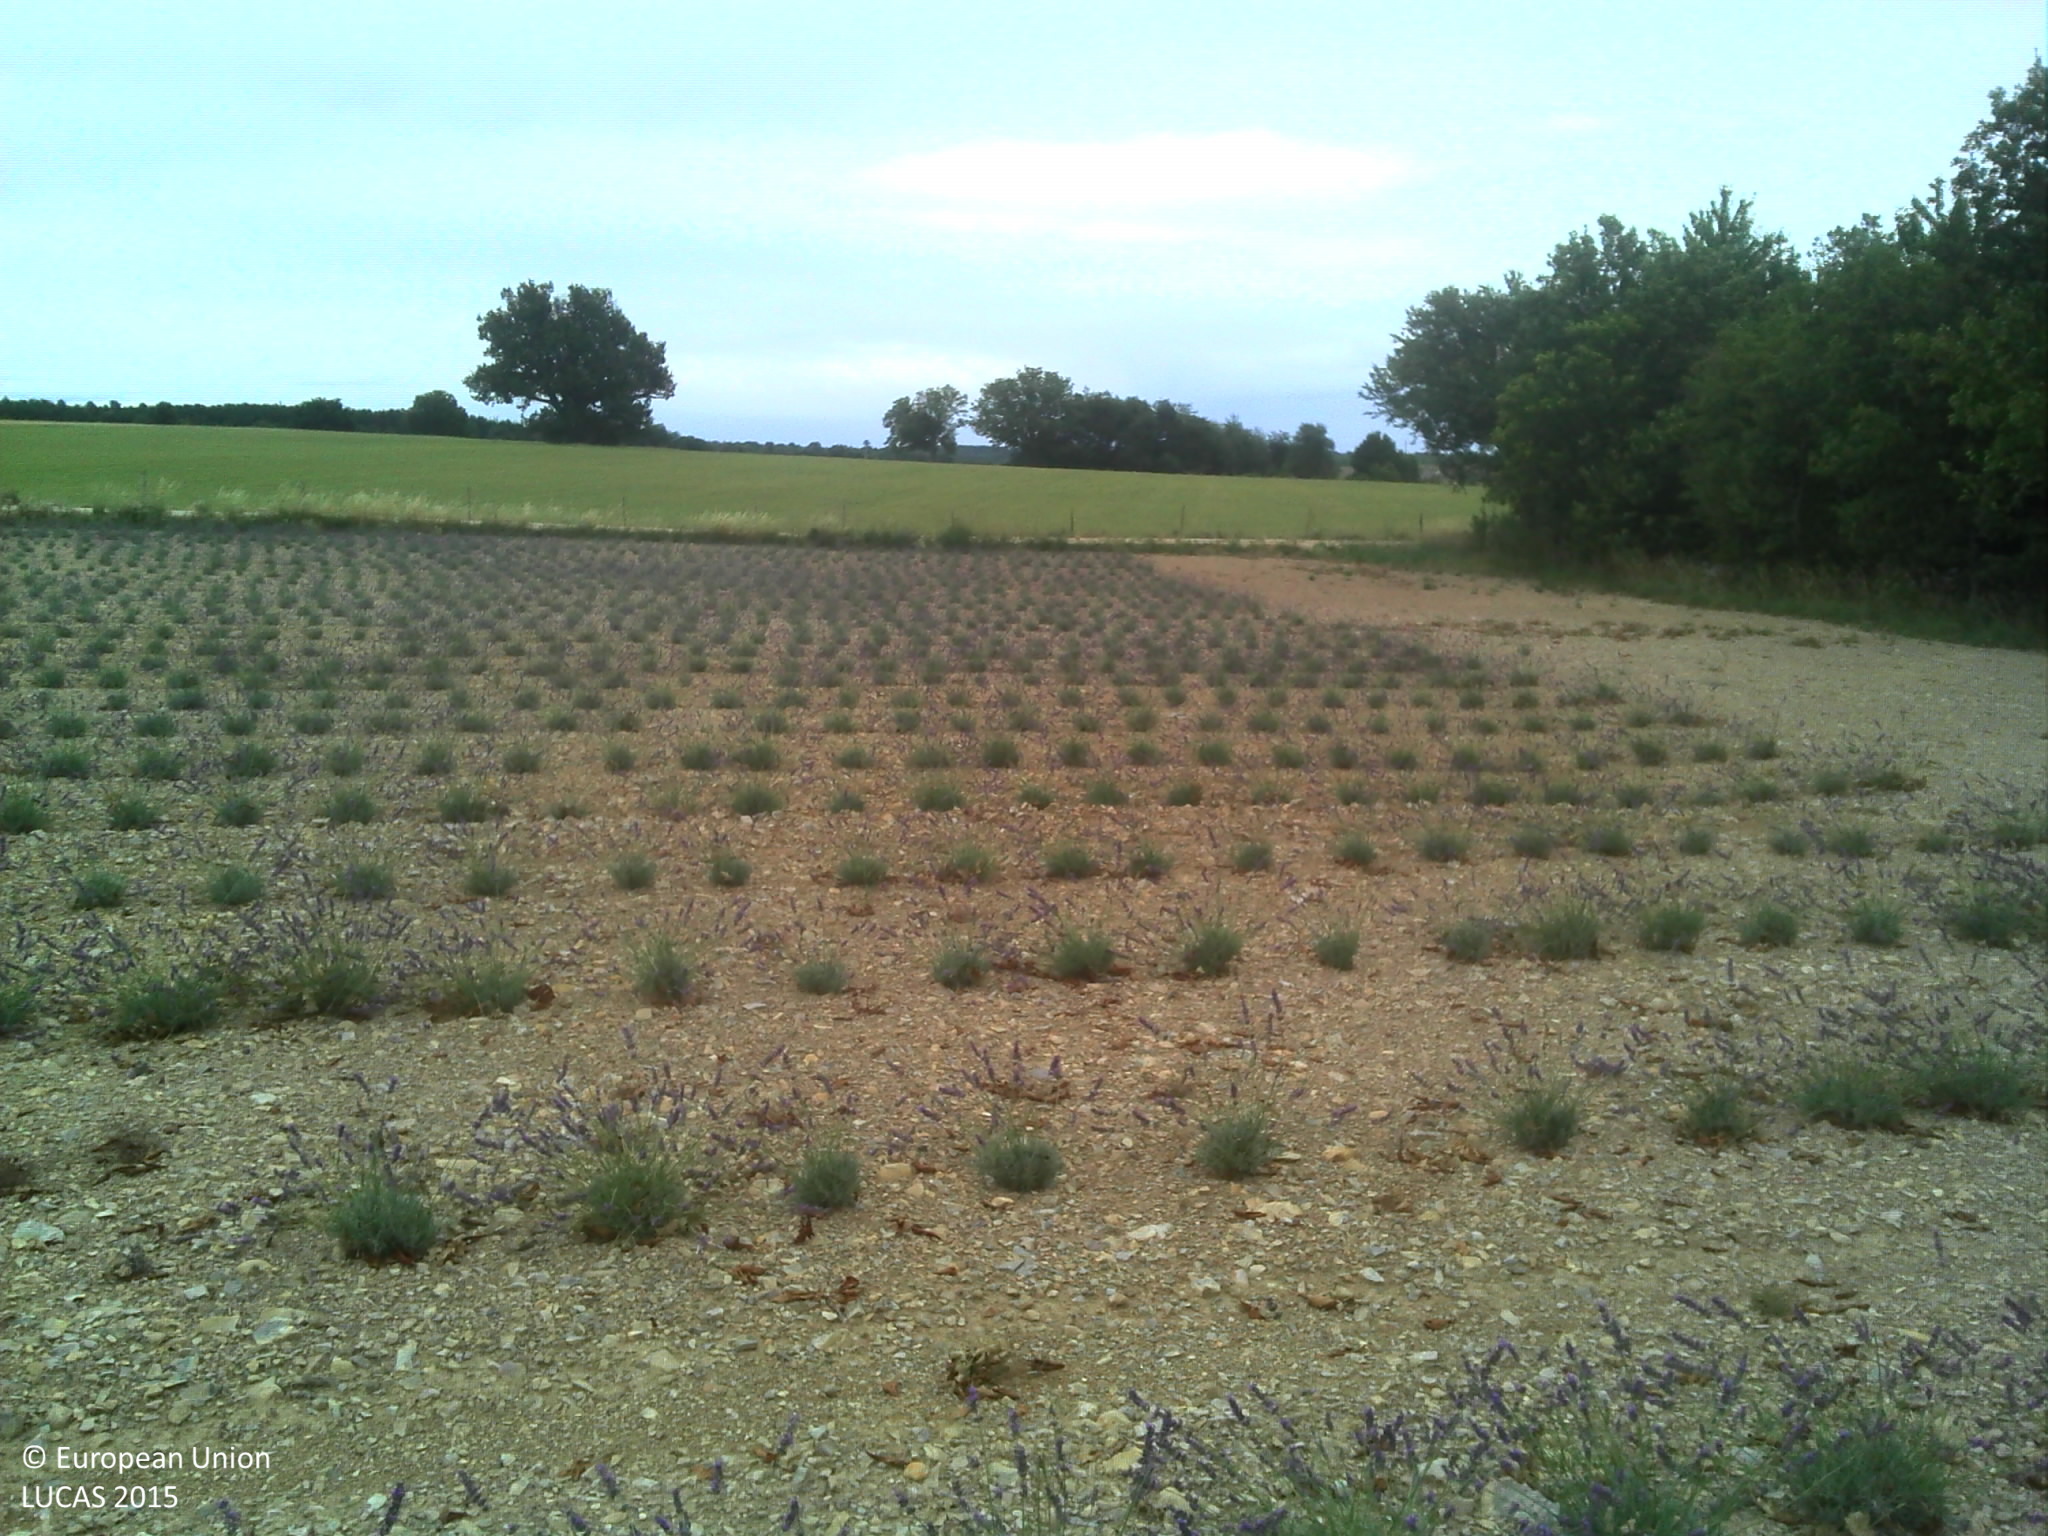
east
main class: Cropland
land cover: Permanent industrial crops
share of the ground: 10 - 25 %
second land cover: Other bare soil
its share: > 75 %
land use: Agriculture (excluding fallow land and kitchen gardens)
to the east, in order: Permanent industrial crops; Other bare soil; Grass margins; Tracks; Grass margins; Fences; Grassland without tree/shrub cover; Grassland with sparse tree/shrub cover; Grassland without tree/shrub cover
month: July
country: FR
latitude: 44.0735
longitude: 5.5255
